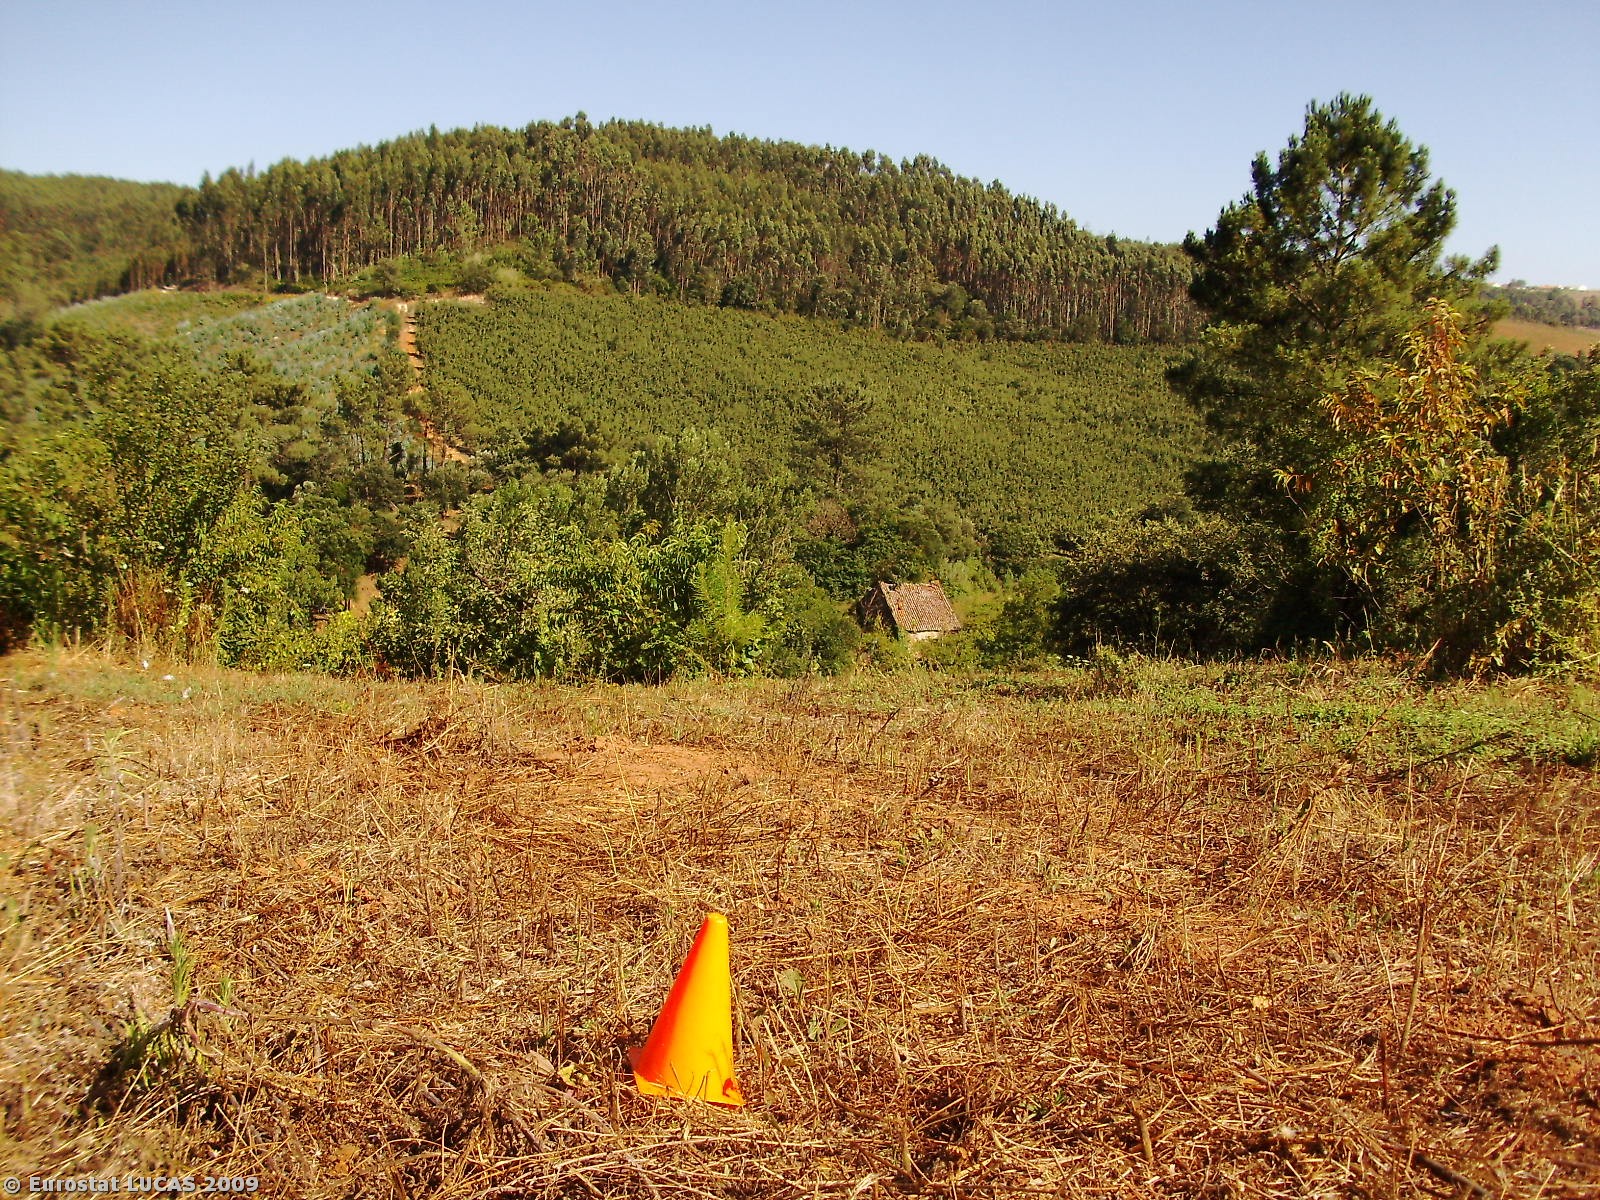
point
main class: Grassland
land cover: Spontaneously vegetated surfaces
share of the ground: > 75 %
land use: Fallow land
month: July
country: PT
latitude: 39.5057
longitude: -8.9850
